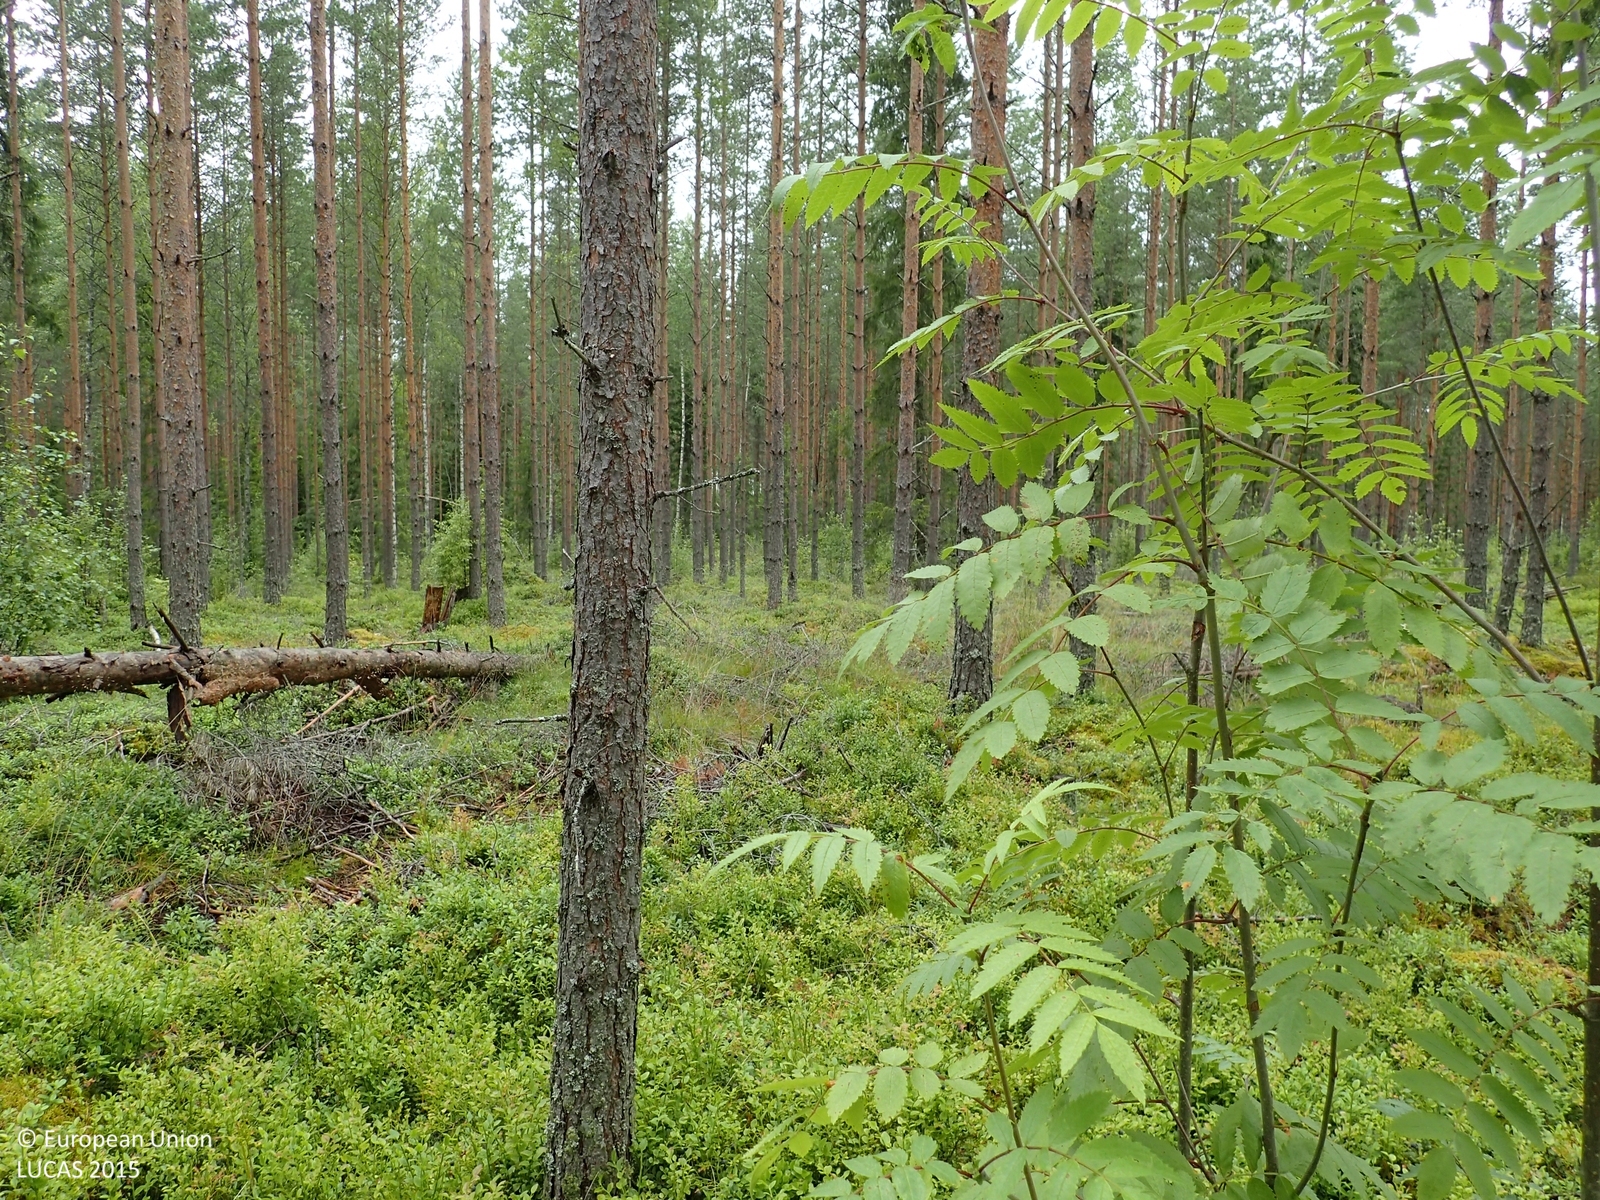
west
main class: Woodland
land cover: Pine dominated coniferous woodland
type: boreal forest
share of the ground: 25 - 50 %
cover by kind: shrubs 60 %, coniferous forest trees 35 %, broadleaved forest trees 5 %
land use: Forestry
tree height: > 5 m
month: July
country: FI
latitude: 62.8183
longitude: 22.7520
